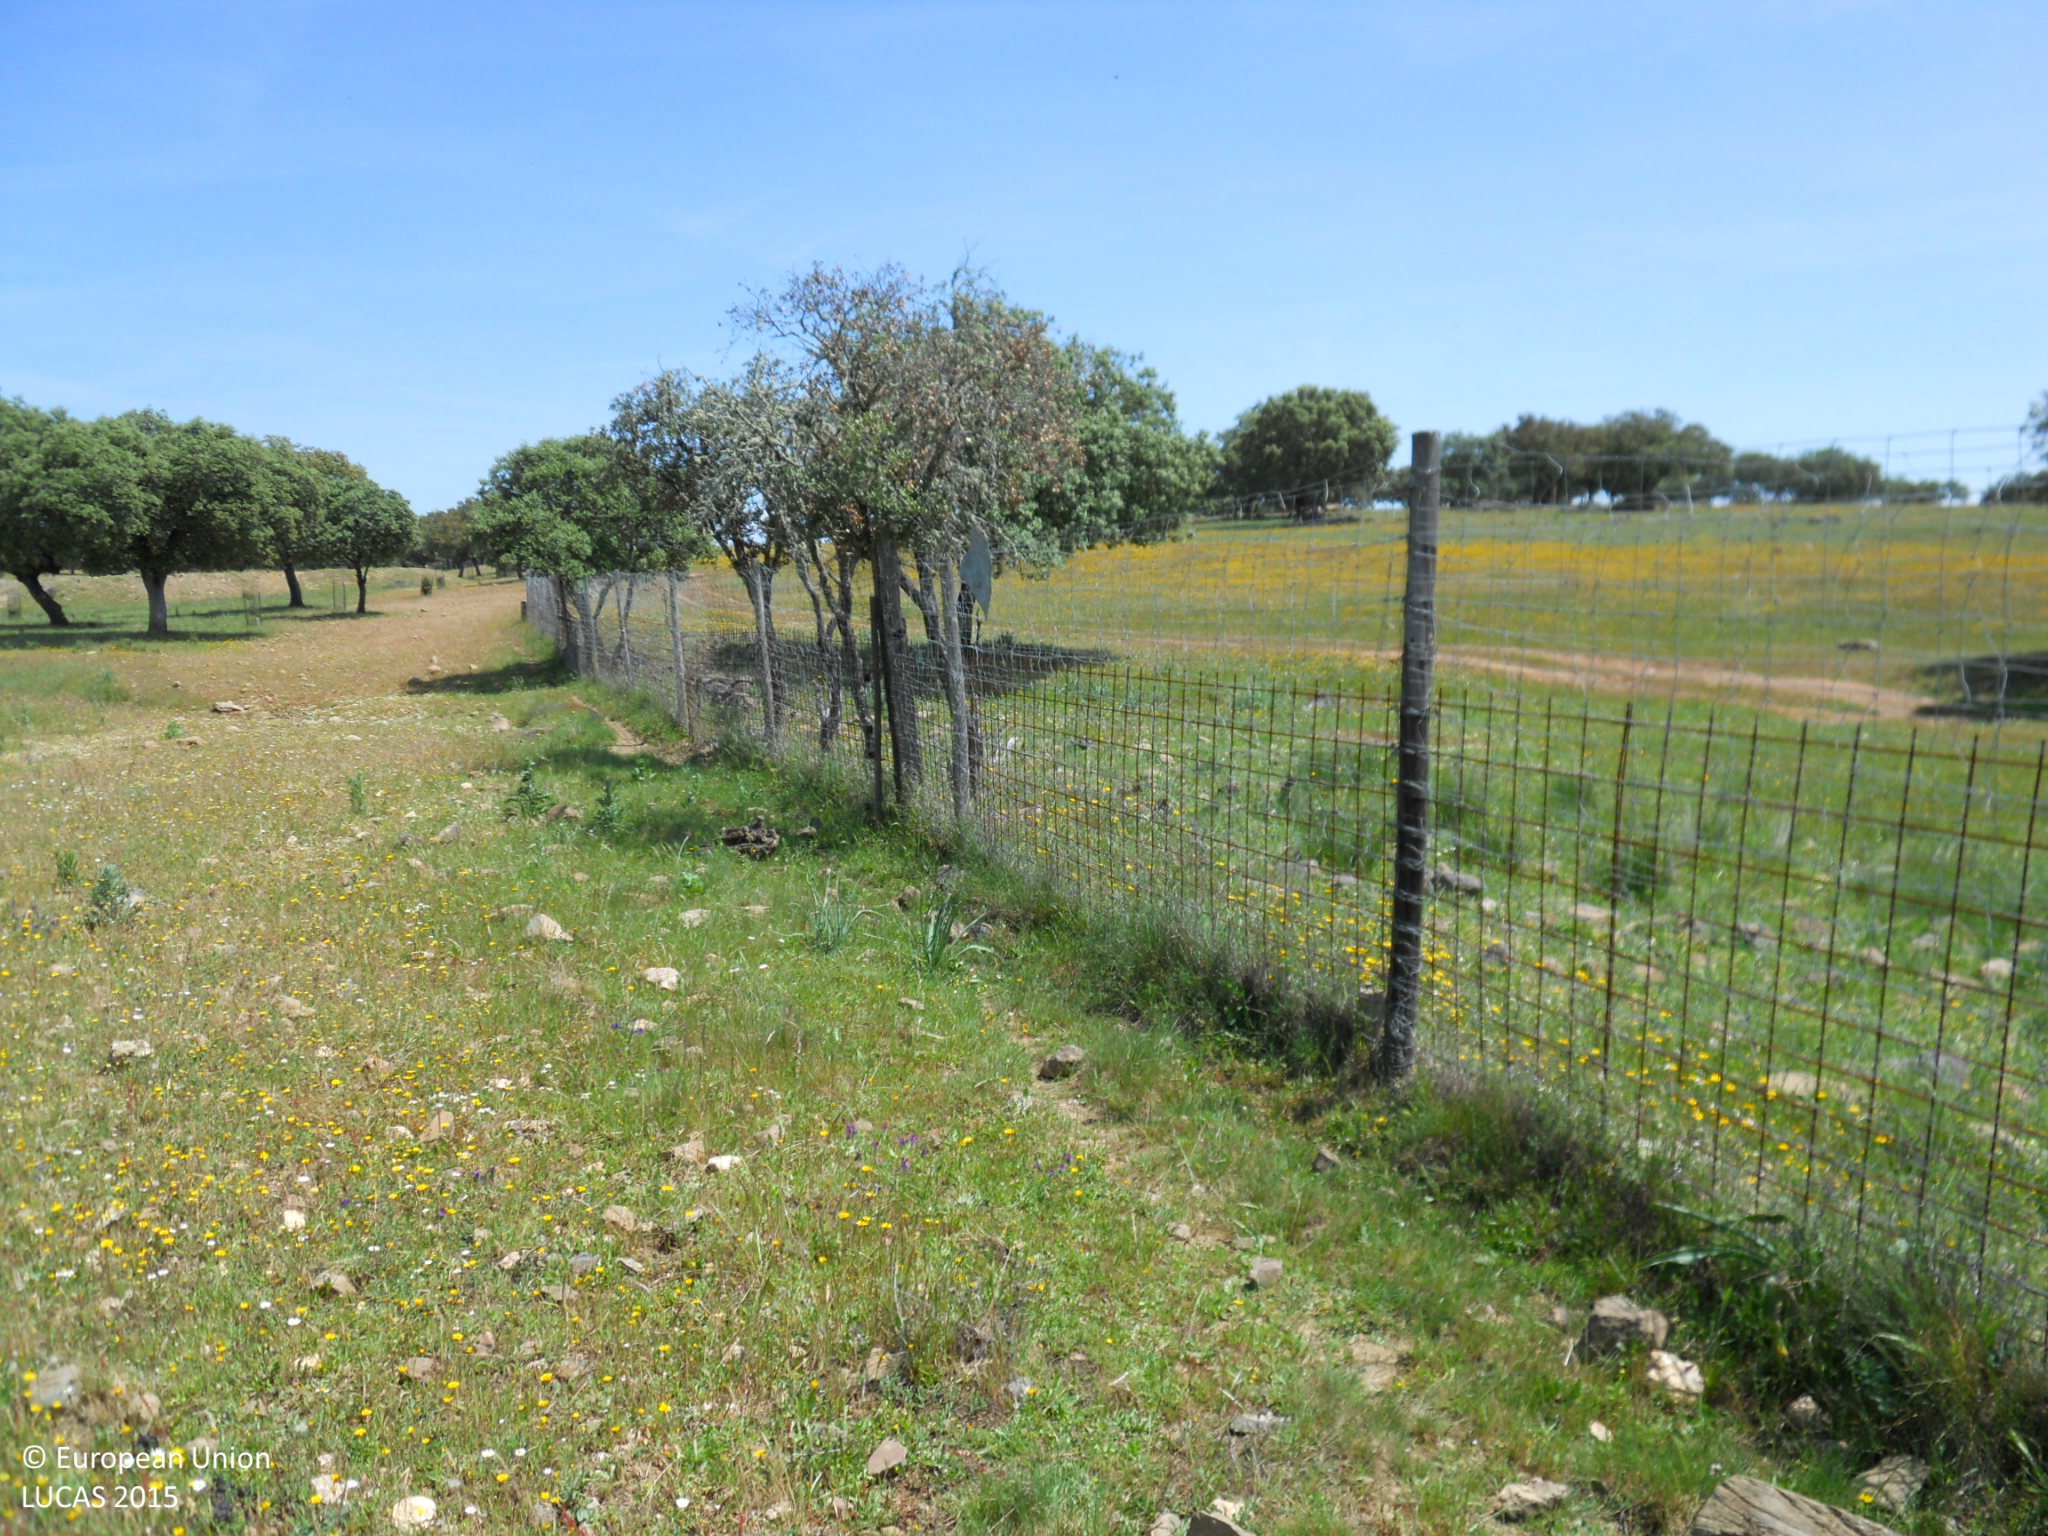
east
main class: Grassland
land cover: Grassland with sparse tree/shrub cover
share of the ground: > 75 %
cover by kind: herbaceous plants 90 %, broadleaved forest trees 5 %, shrubs 5 %
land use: Agriculture (excluding fallow land and kitchen gardens)
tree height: < 5 m
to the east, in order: Grassland with sparse tree/shrub cover; Fences; Grassland with sparse tree/shrub cover; Tracks; Grassland with sparse tree/shrub cover
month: April
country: ES
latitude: 39.1680
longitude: -6.8433
